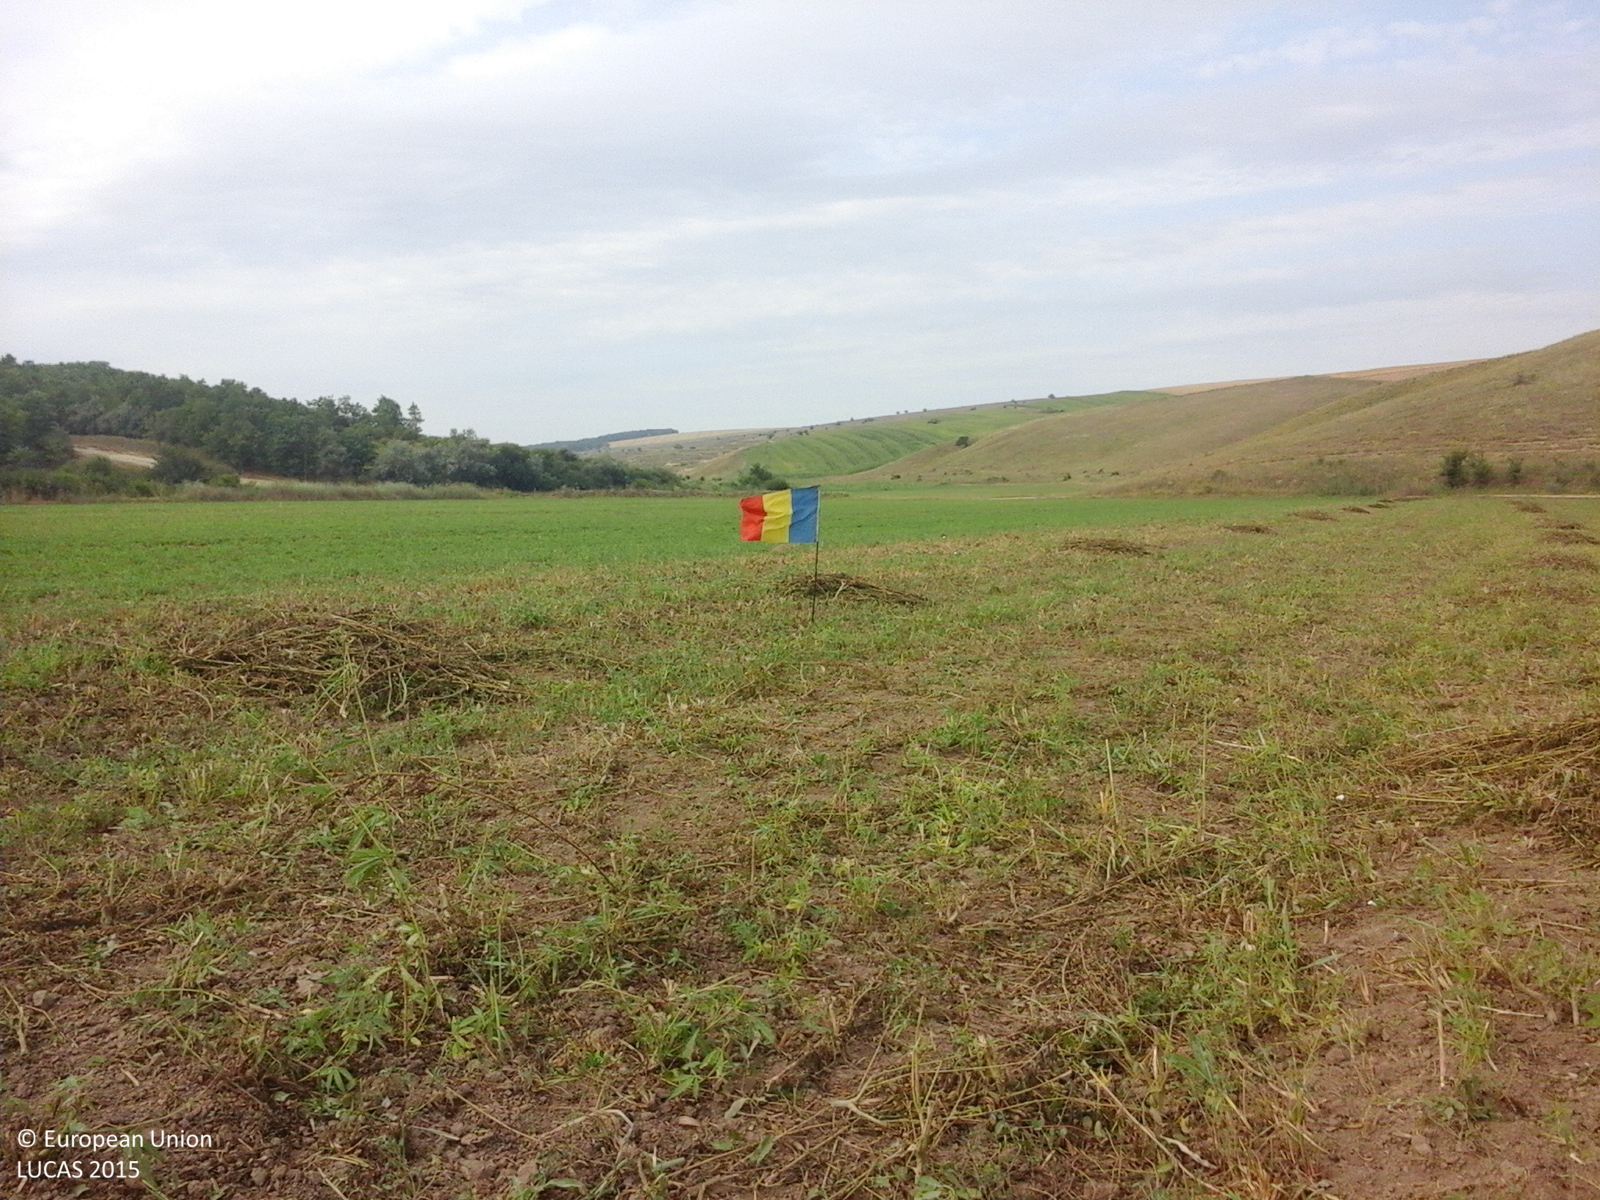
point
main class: Cropland
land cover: Lucerne
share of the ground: 10 - 25 %
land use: Agriculture (excluding fallow land and kitchen gardens)
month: August
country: RO
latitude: 44.1231
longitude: 27.9085
